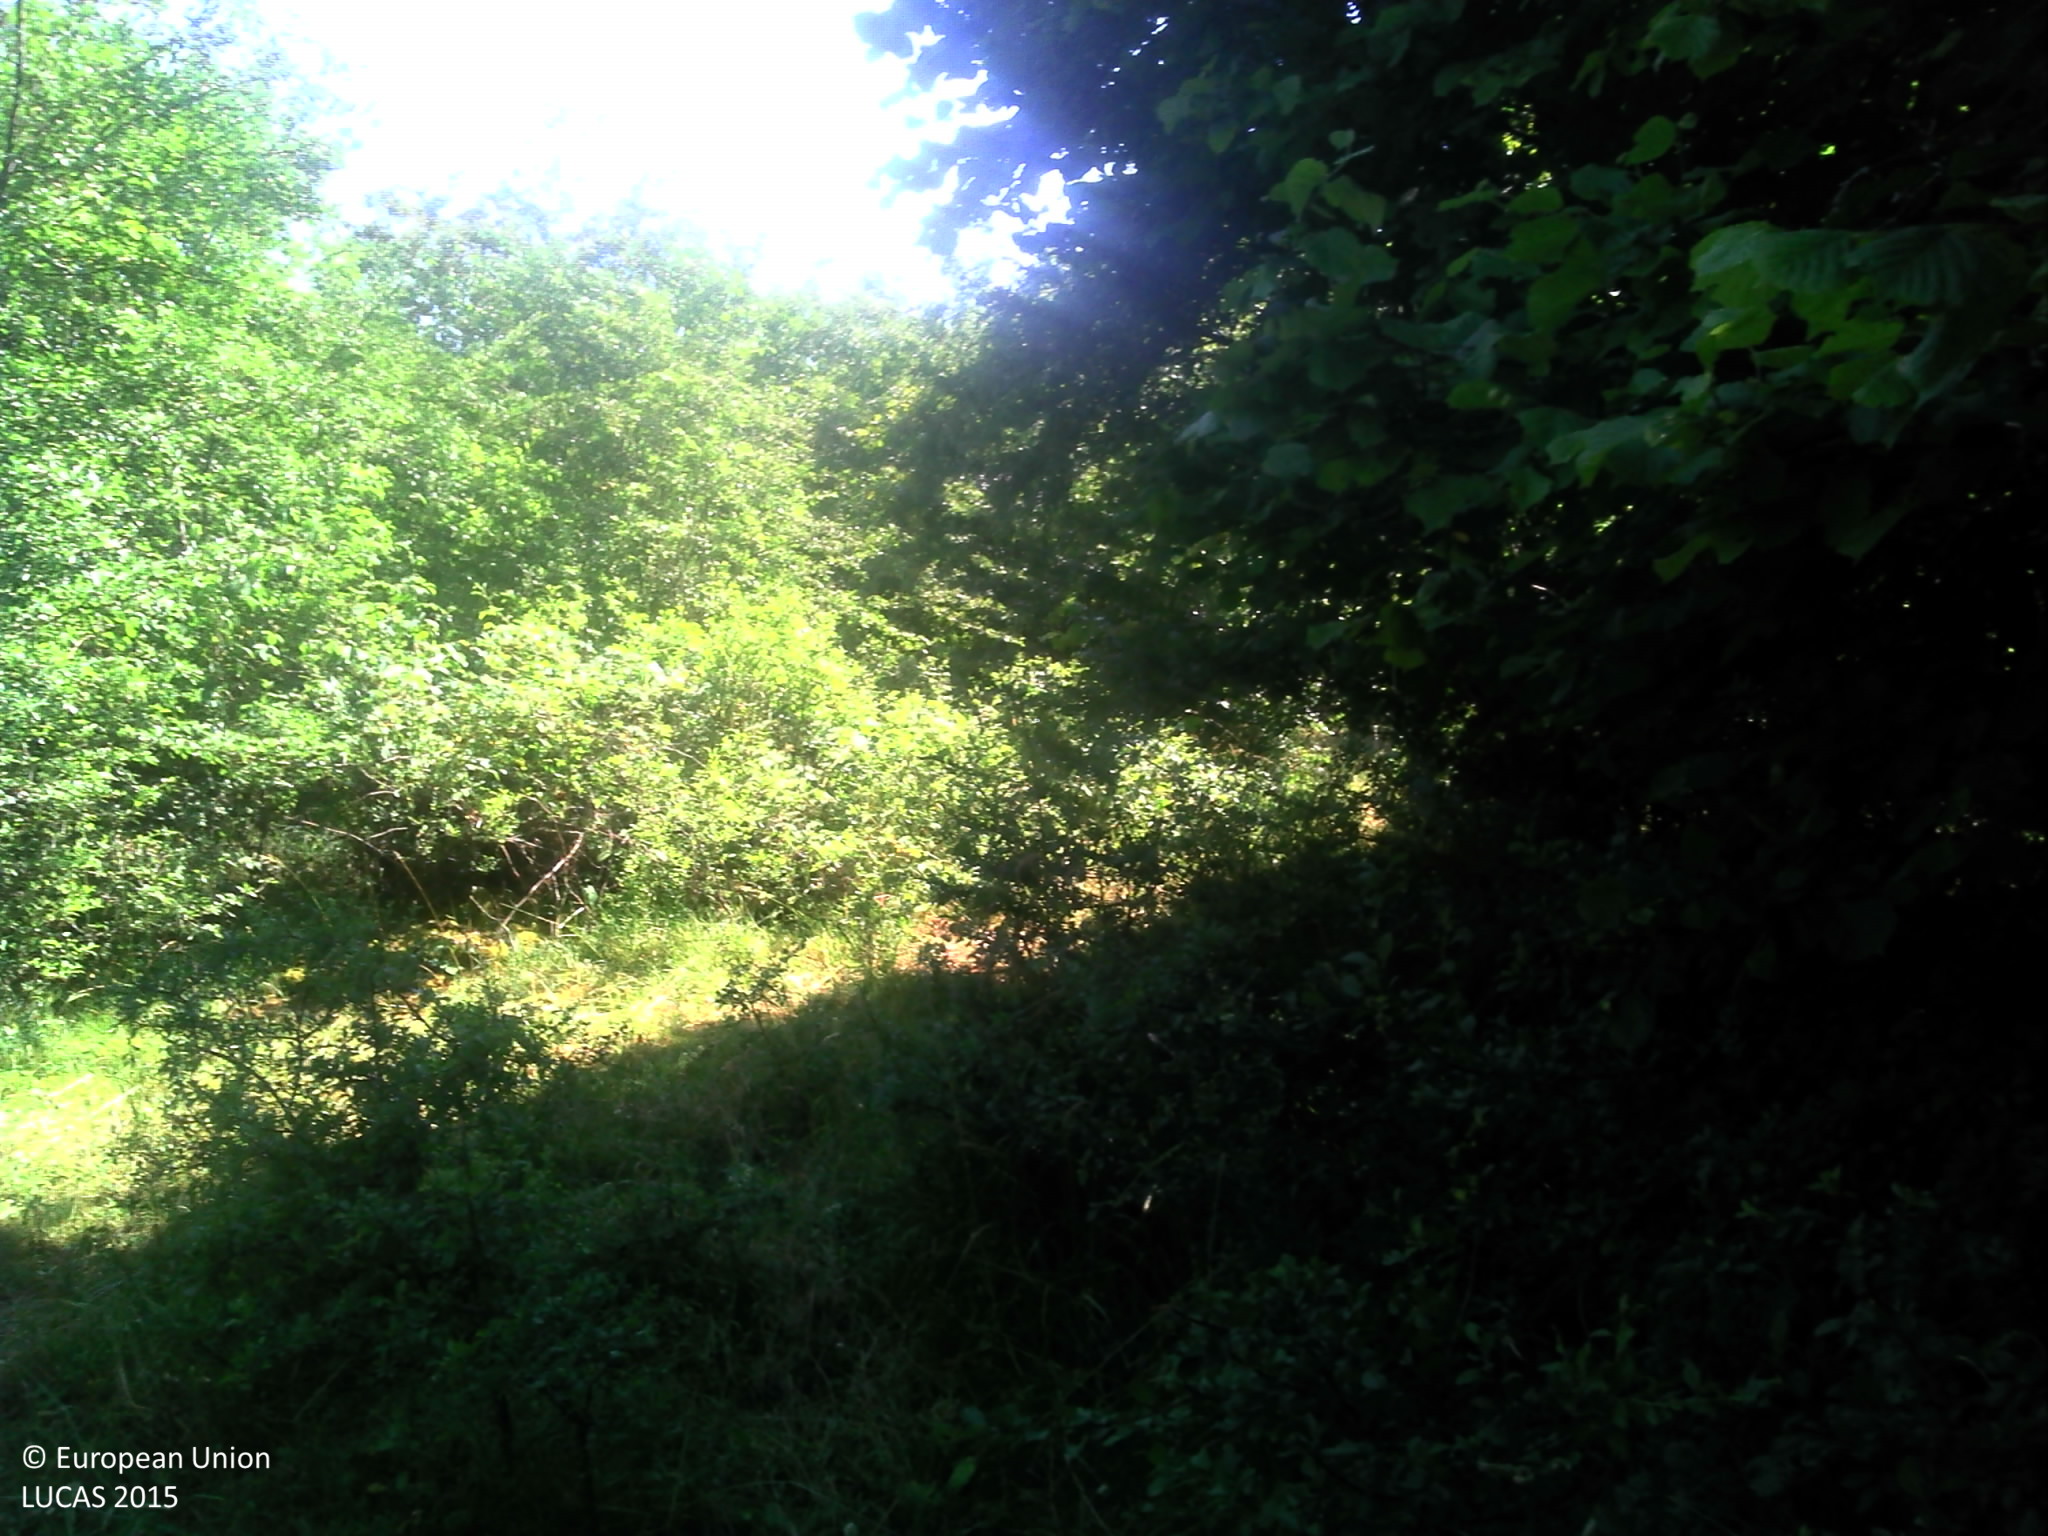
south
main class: Woodland
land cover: Broadleaved woodland
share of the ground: 10 - 25 %
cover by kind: herbaceous plants 70 %, broadleaved forest trees 20 %, shrubs 10 %
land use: Forestry
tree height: < 5 m
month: July
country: FR
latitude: 48.1261
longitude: 5.3644
